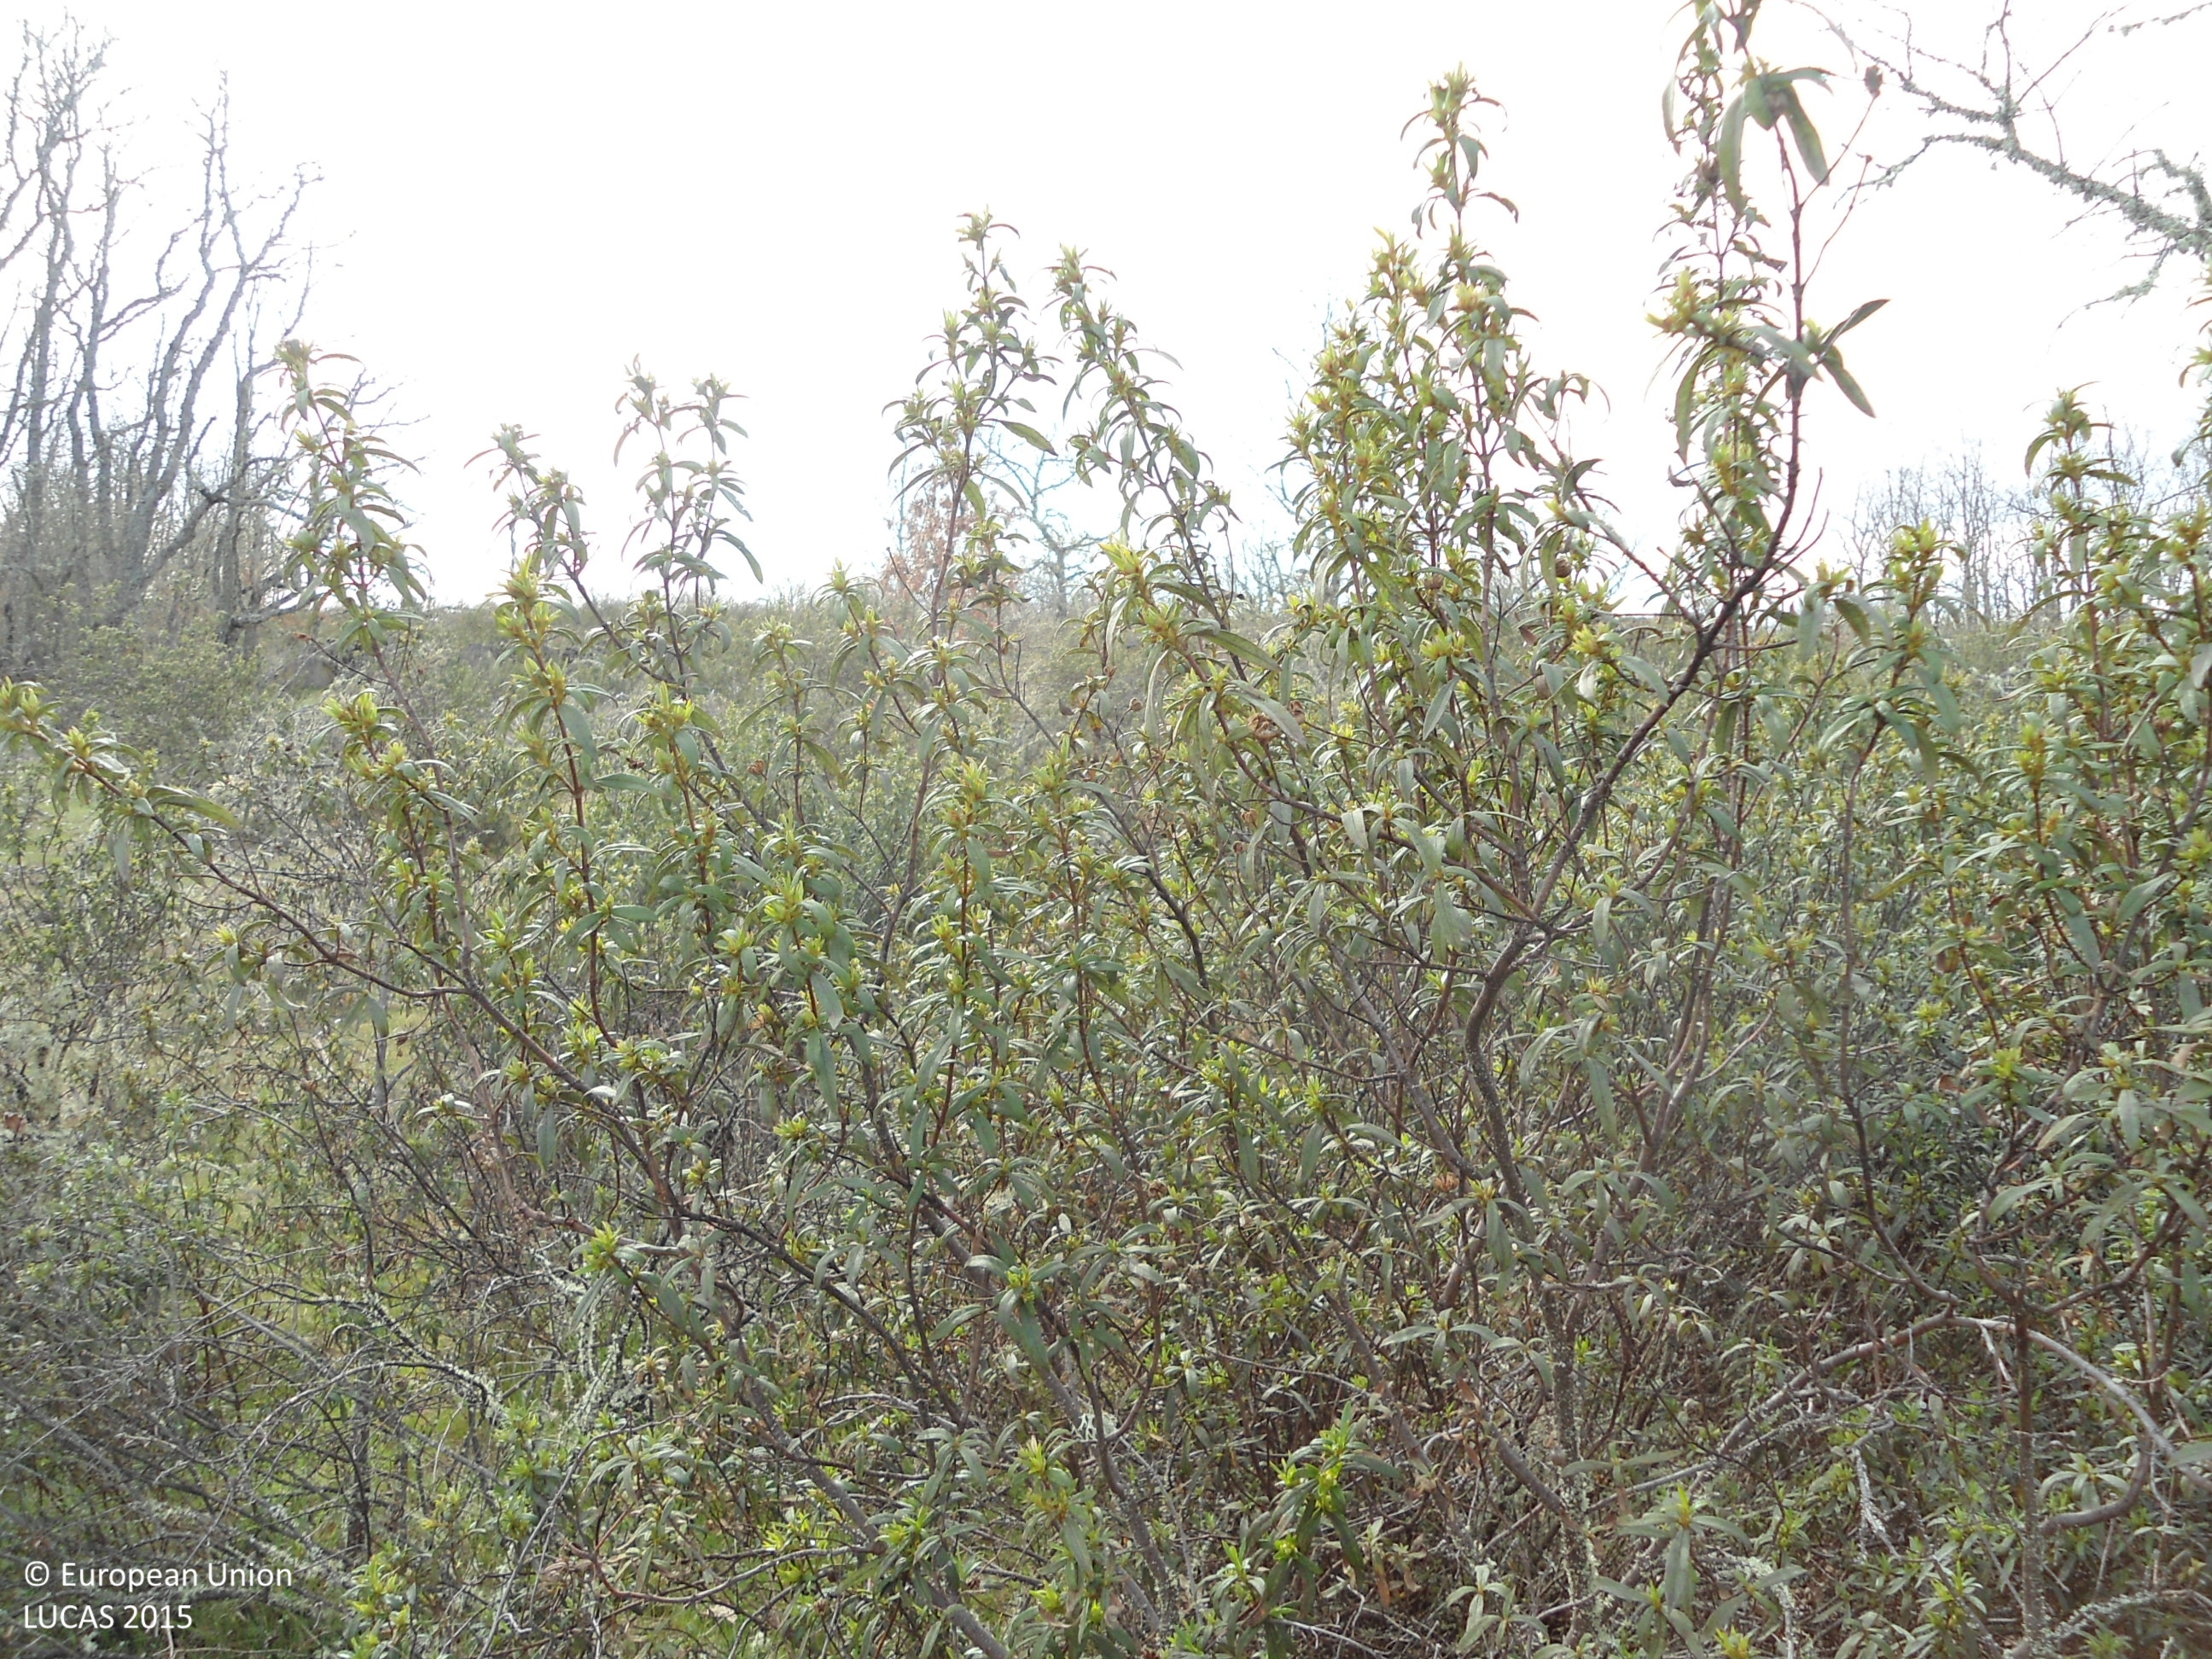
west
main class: Woodland
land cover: Broadleaved woodland
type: acidophilous oak and oak-birch forest
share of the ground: 25 - 50 %
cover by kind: broadleaved forest trees 50 %, shrubs 40 %, herbaceous plants 10 %
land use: Forestry
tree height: > 5 m
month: April
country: ES
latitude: 41.6660
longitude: -6.2287
